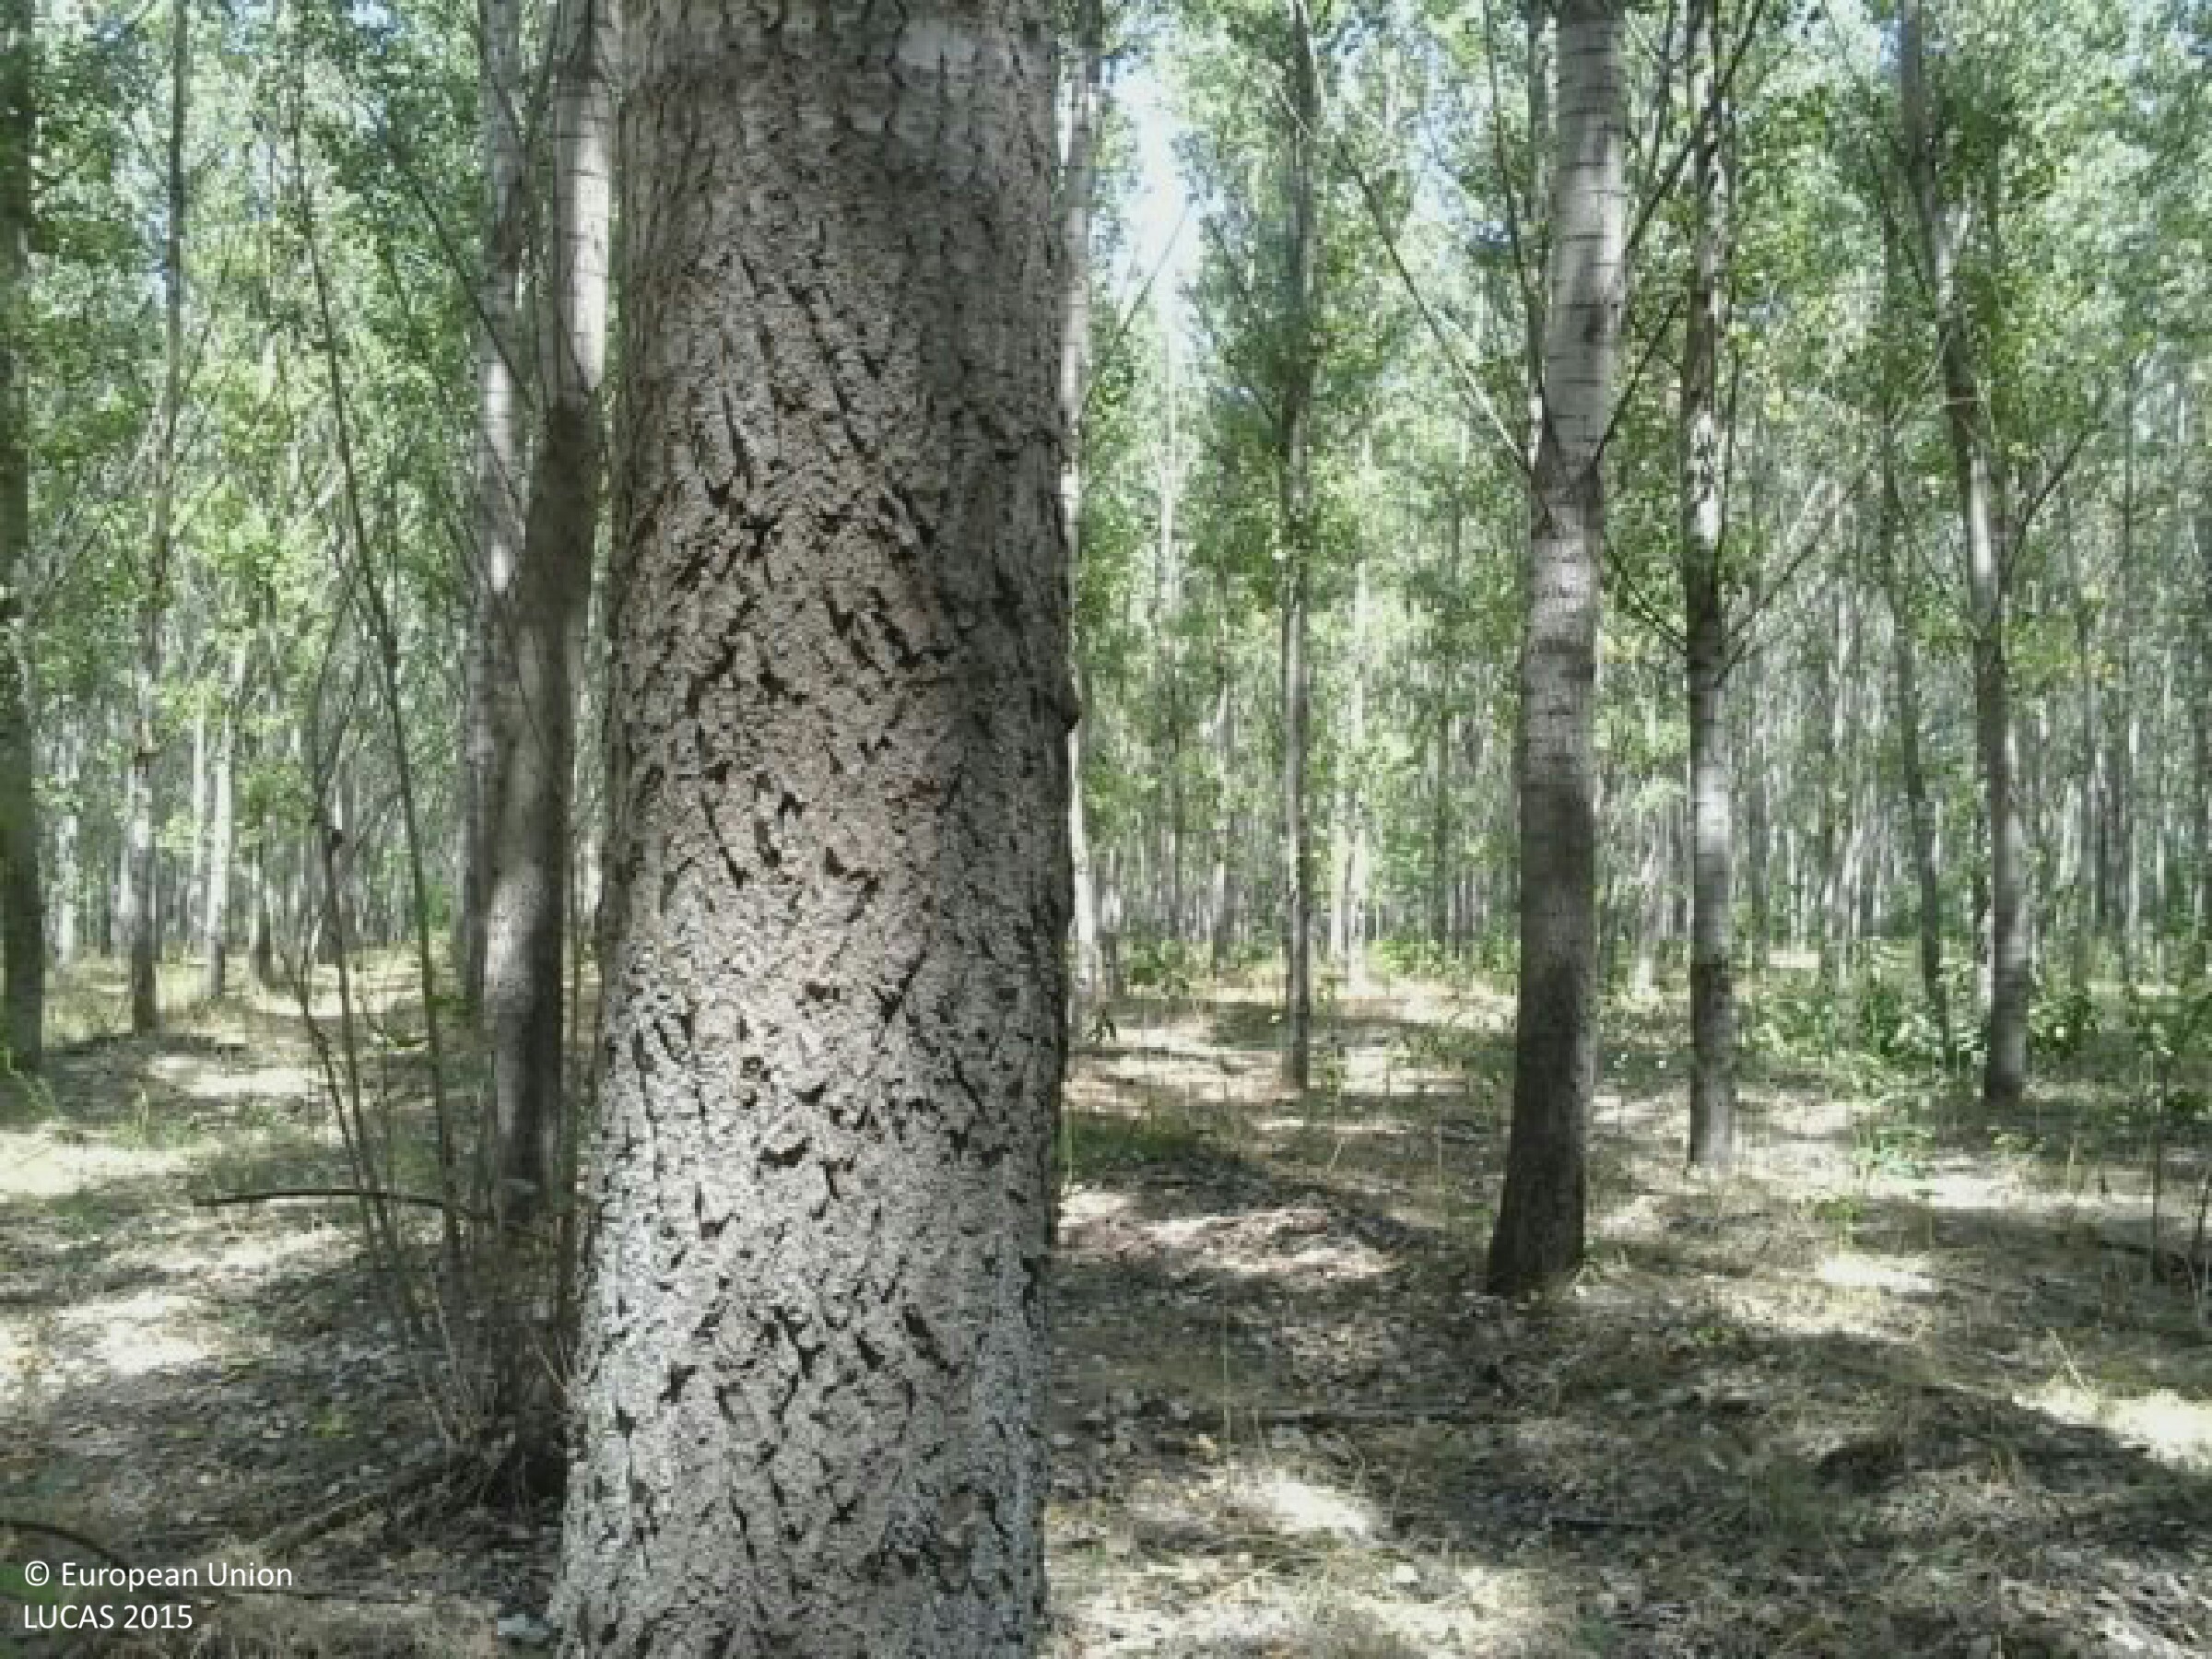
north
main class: Woodland
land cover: Broadleaved woodland
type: mesophytic deciduous forest
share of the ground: > 75 %
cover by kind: broadleaved forest trees 85 %, herbaceous plants 10 %, shrubs 5 %
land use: Forestry
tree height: > 5 m
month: August
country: HU
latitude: 46.9843
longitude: 19.8434
